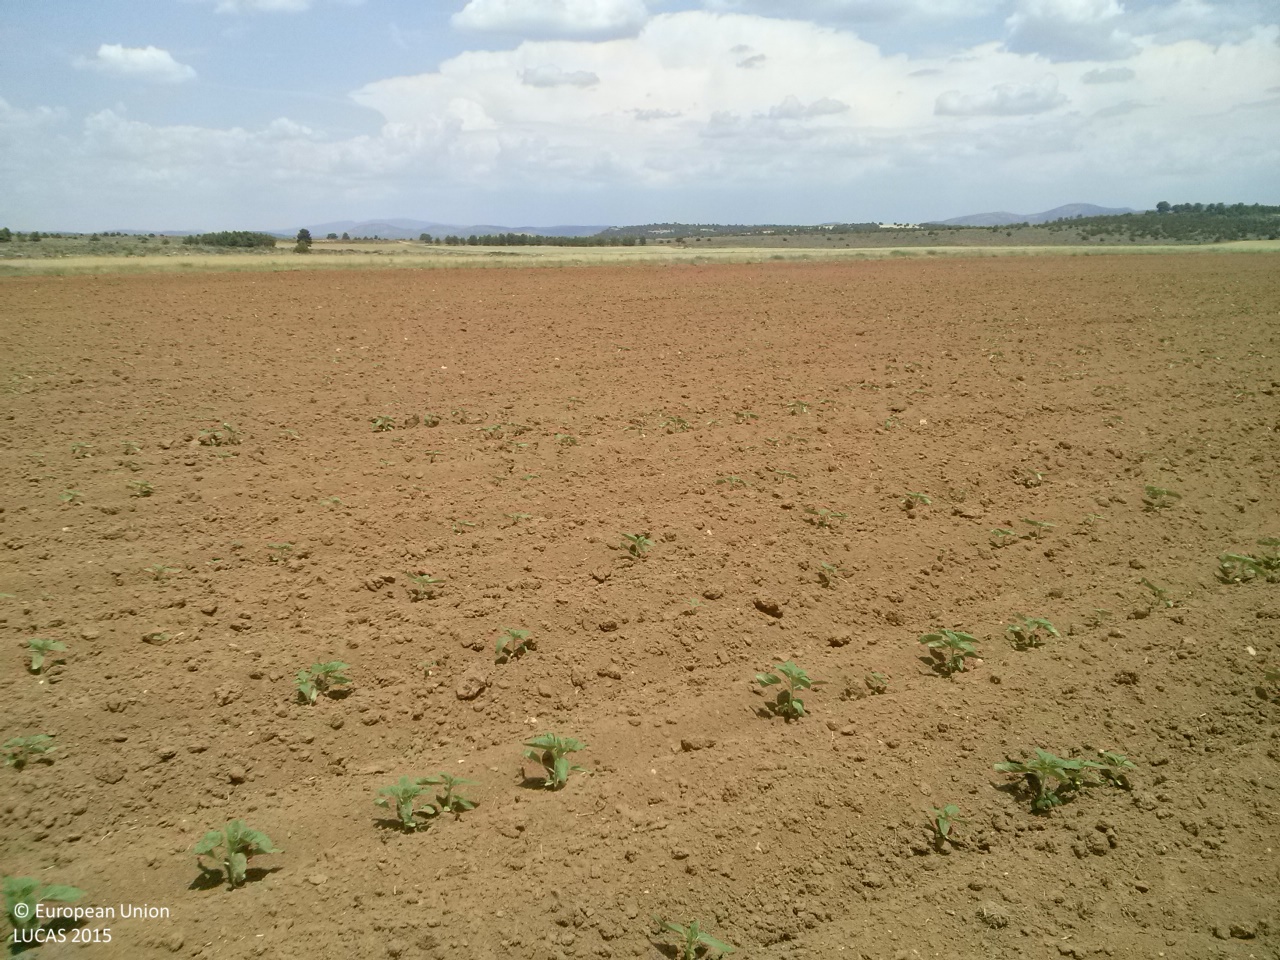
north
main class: Cropland
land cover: Sunflower
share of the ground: < 10 %
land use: Agriculture (excluding fallow land and kitchen gardens)
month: June
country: ES
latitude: 39.9188
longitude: -1.7924
